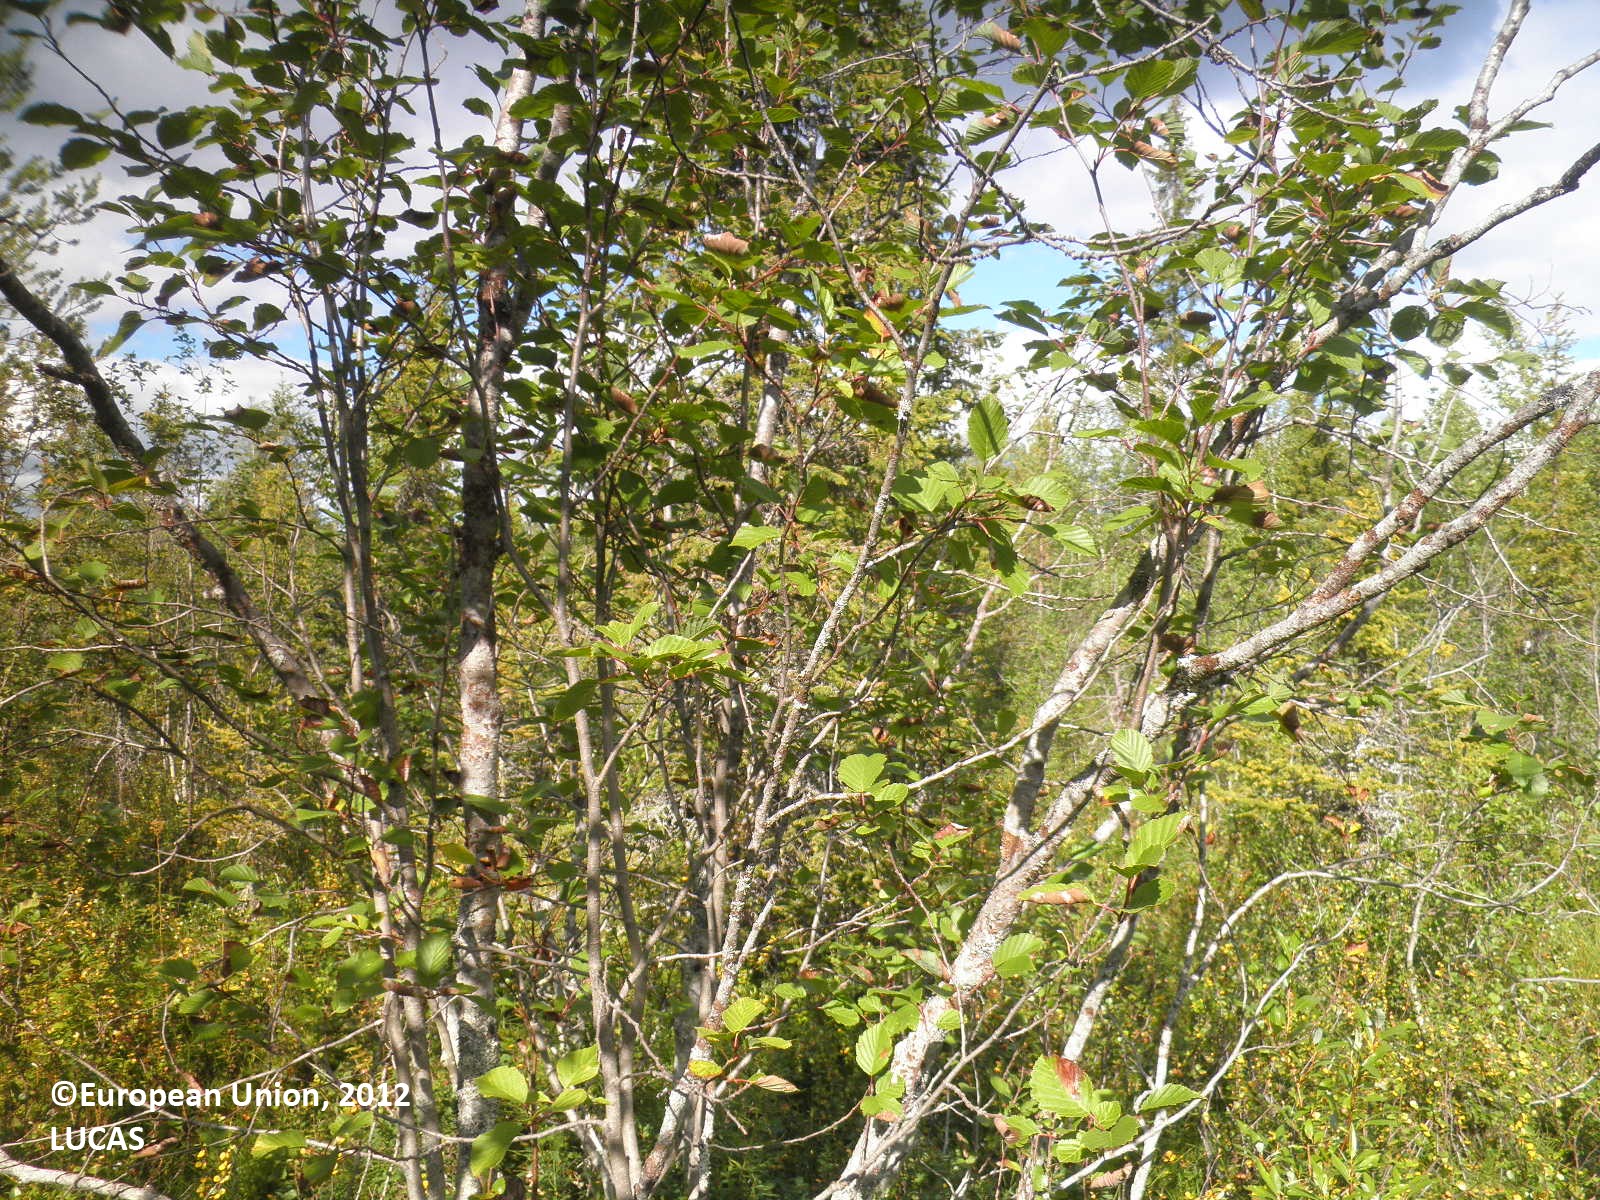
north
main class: Woodland
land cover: Spruce dominated mixed woodland
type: boreal forest
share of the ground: 50 - 75 %
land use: Forestry
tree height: > 5 m
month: August
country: FI
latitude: 67.5549
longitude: 26.1394
